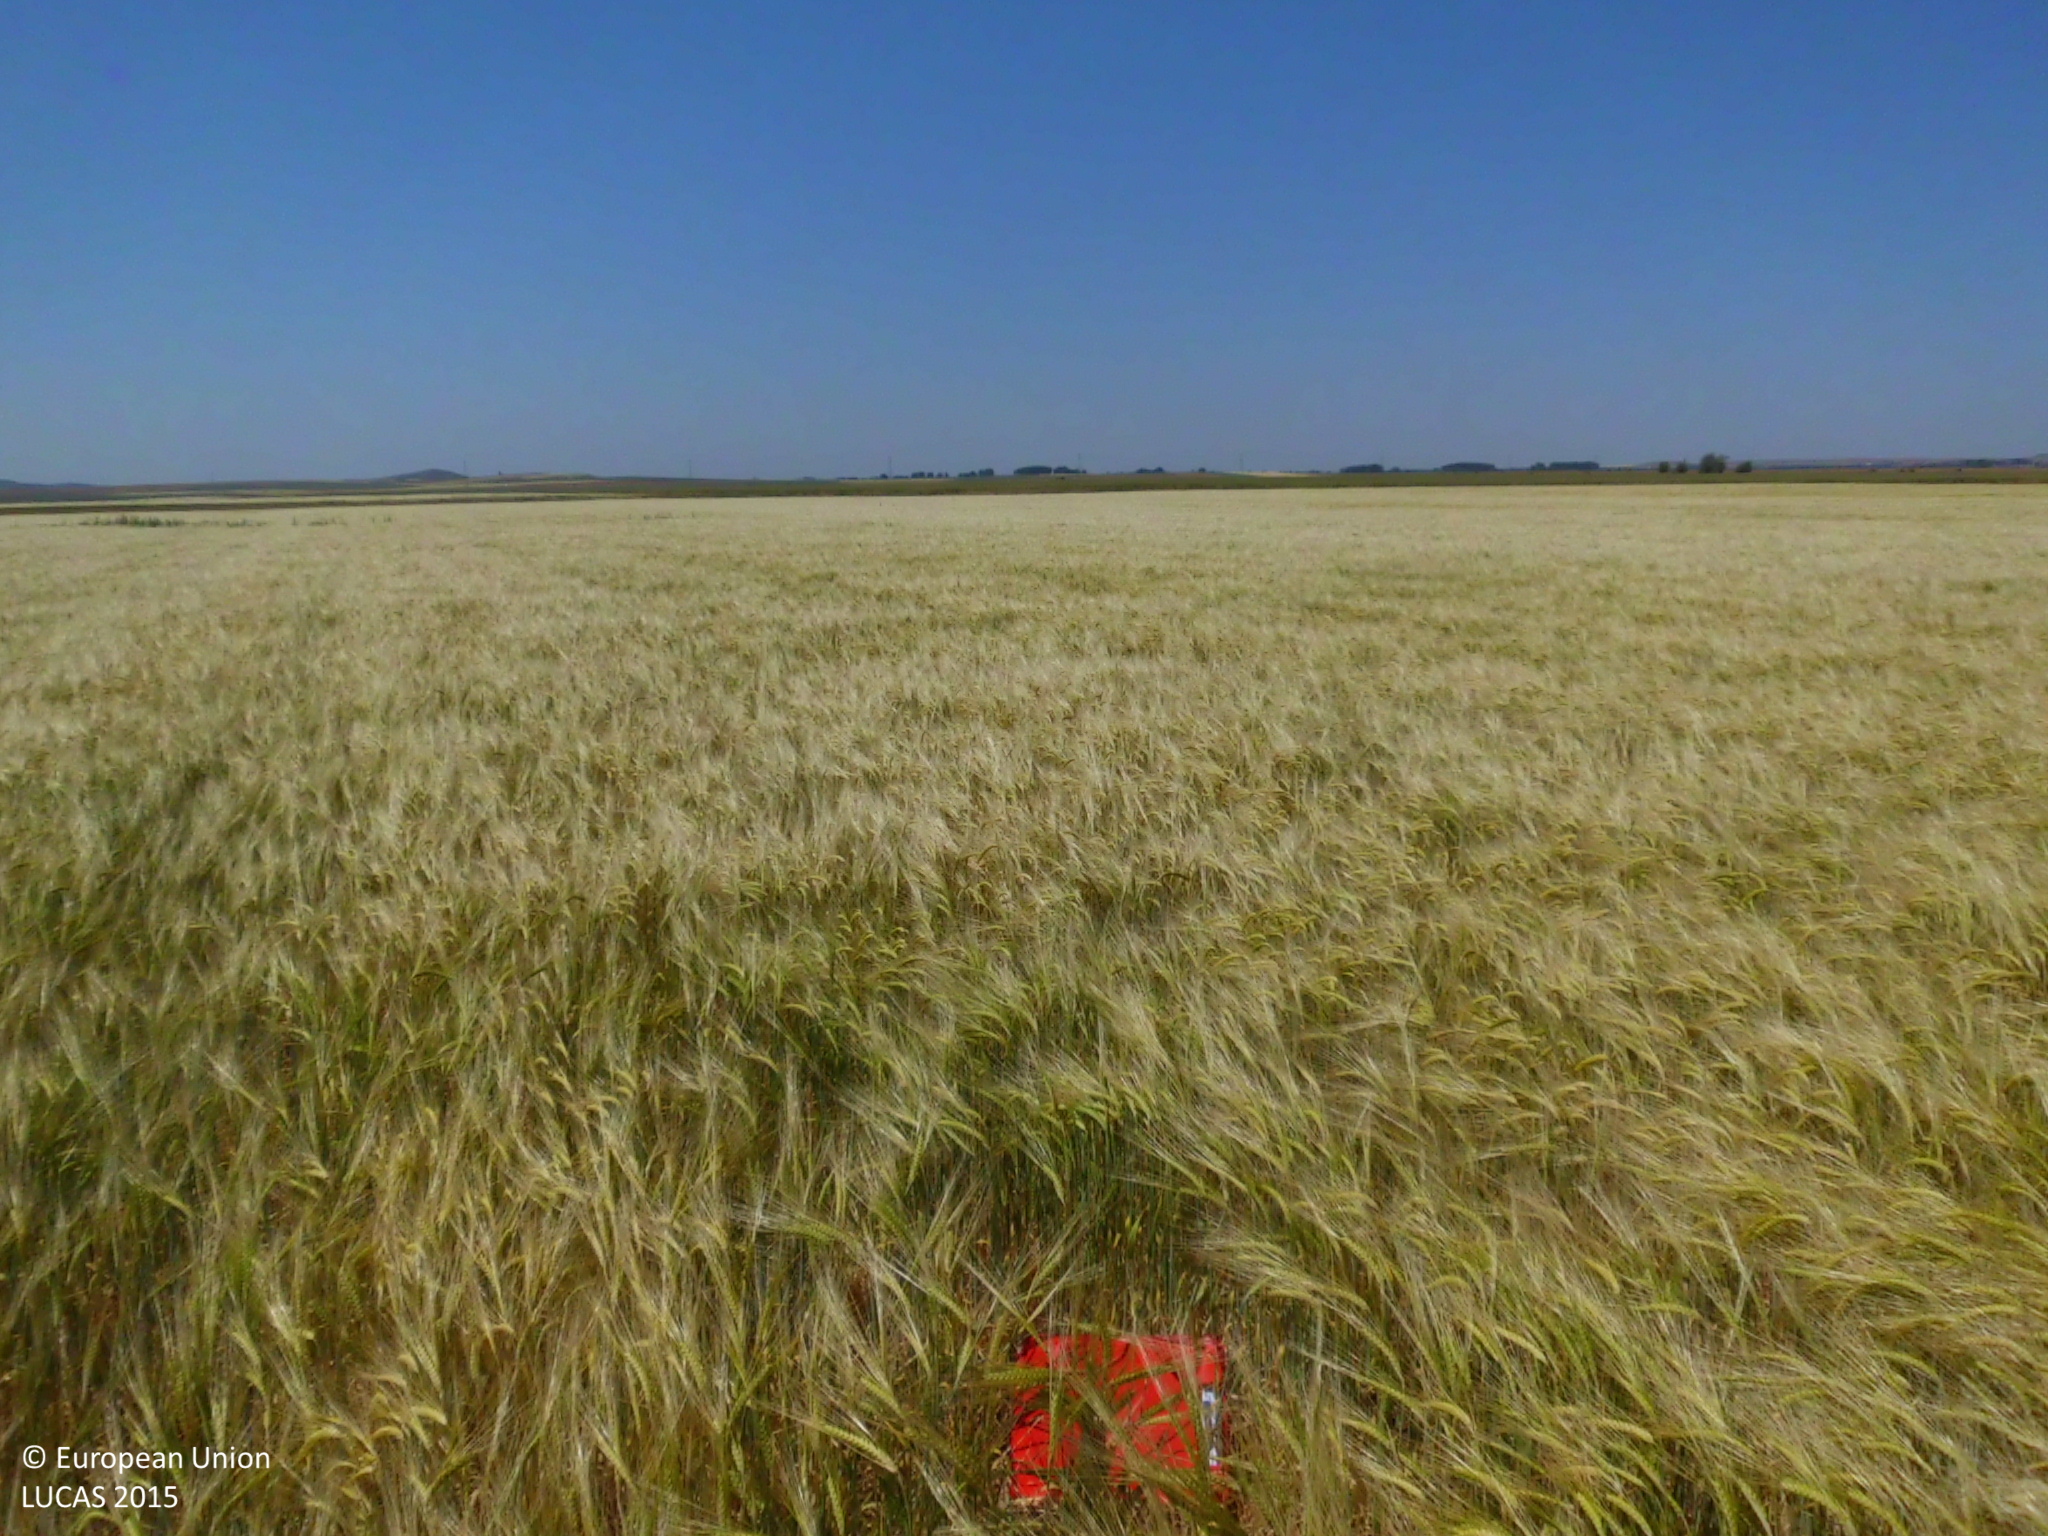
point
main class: Cropland
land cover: Barley
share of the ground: > 75 %
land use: Agriculture (excluding fallow land and kitchen gardens)
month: June
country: ES
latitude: 42.3809
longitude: -4.1940
